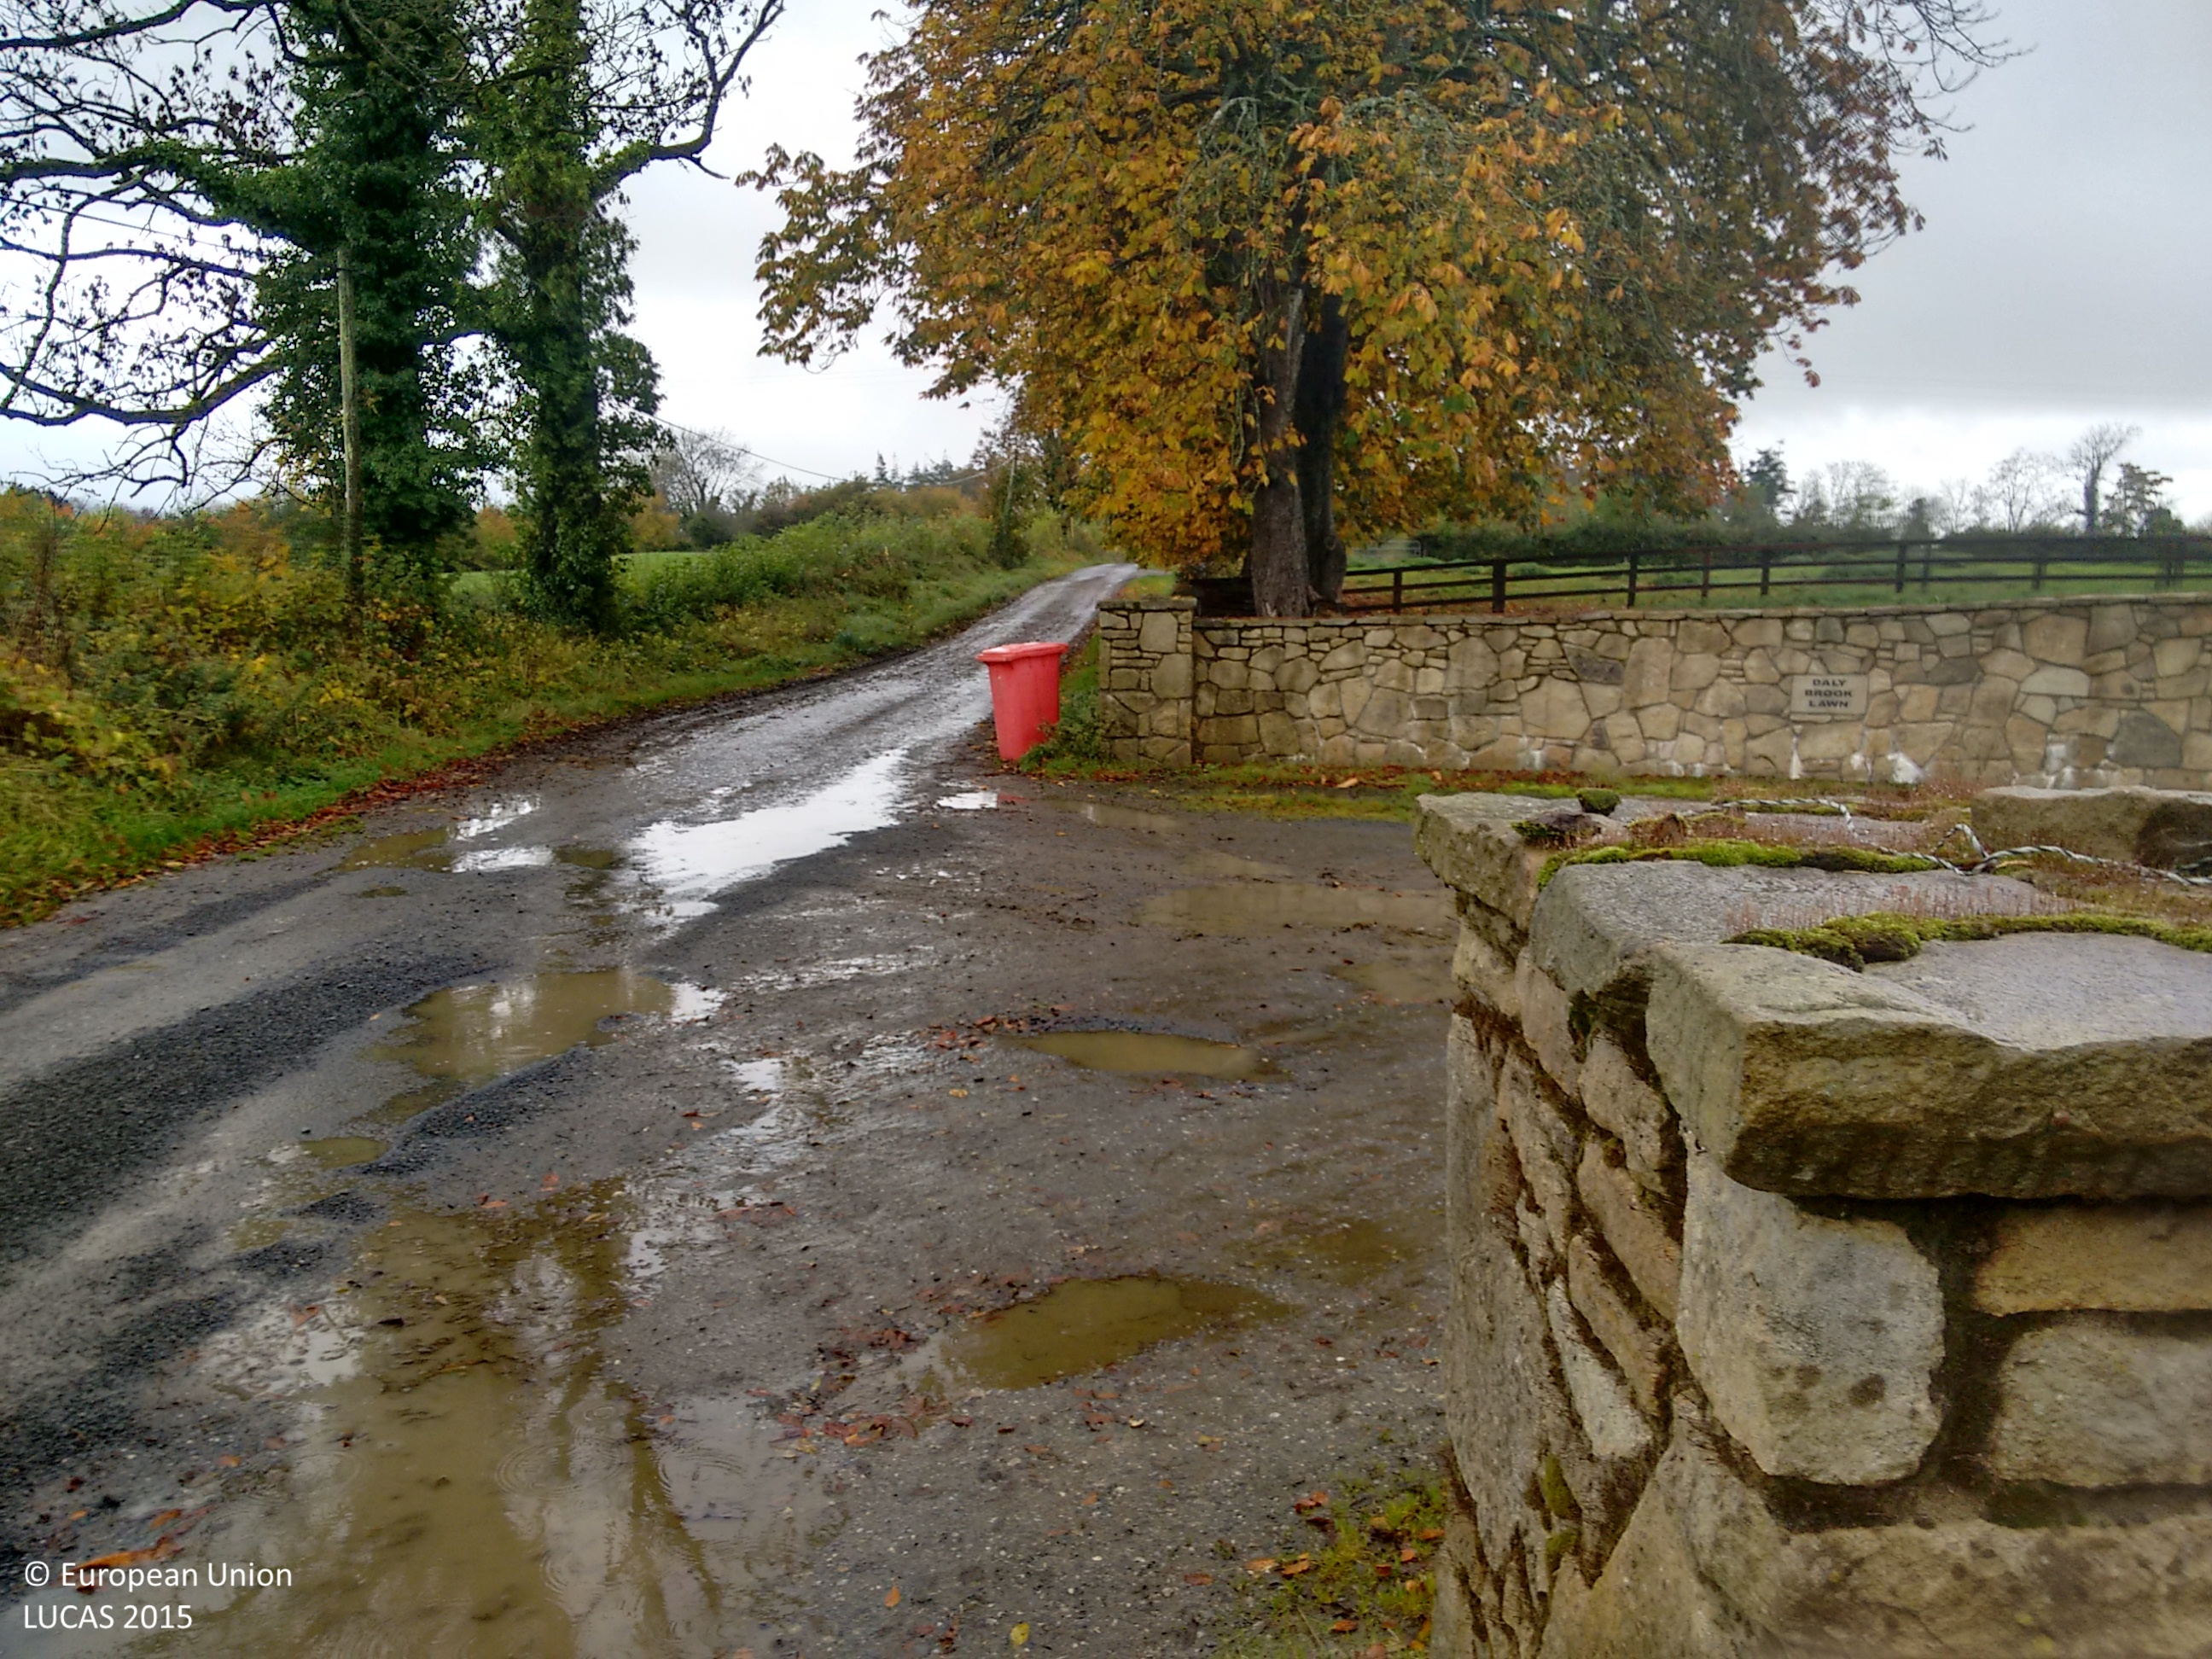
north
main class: Grassland
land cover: Grassland without tree/shrub cover
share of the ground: > 75 %
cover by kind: herbaceous plants 50 %, consolidated bare surface 15 %
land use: Agriculture (excluding fallow land and kitchen gardens)
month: October
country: IE
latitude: 52.9601
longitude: -7.6251
